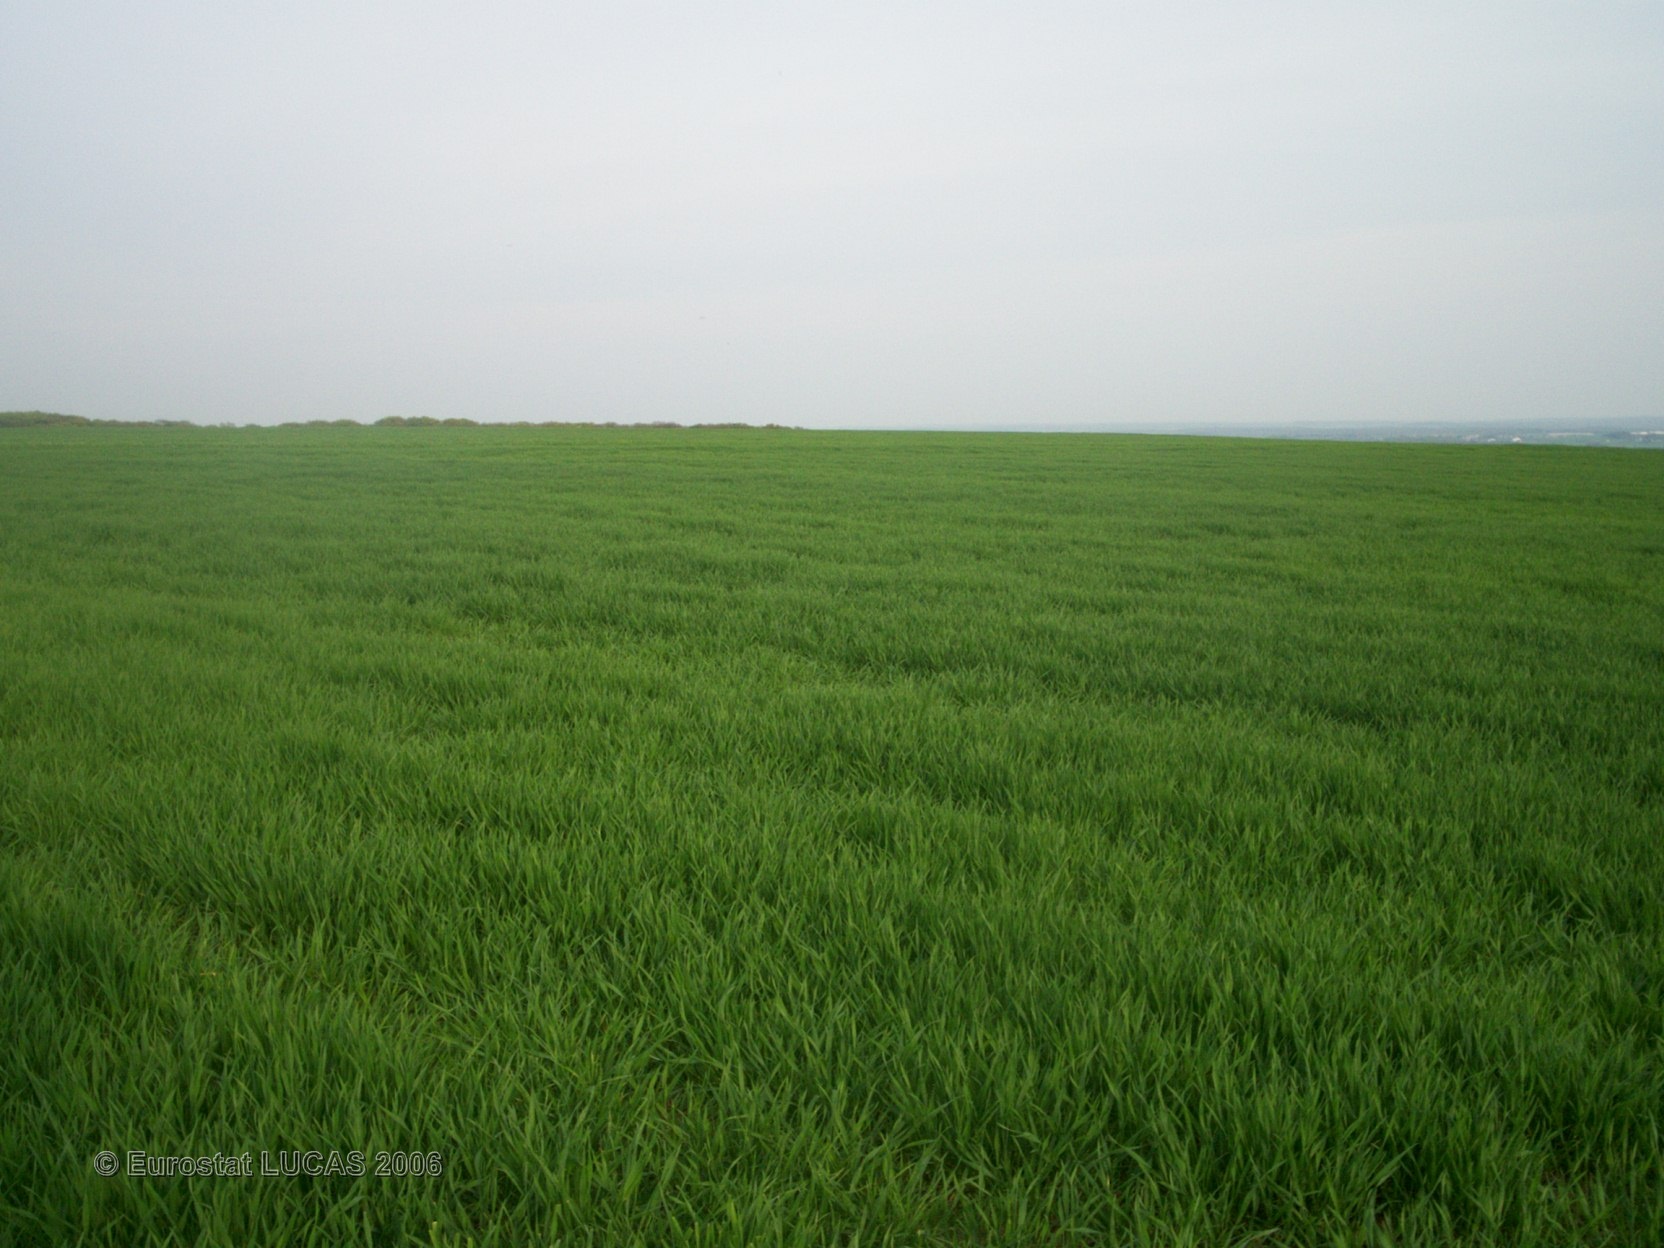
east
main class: Cropland
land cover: Common wheat
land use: Agriculture (excluding fallow land and kitchen gardens)
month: May
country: FR
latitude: 49.1362
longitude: 6.9712
